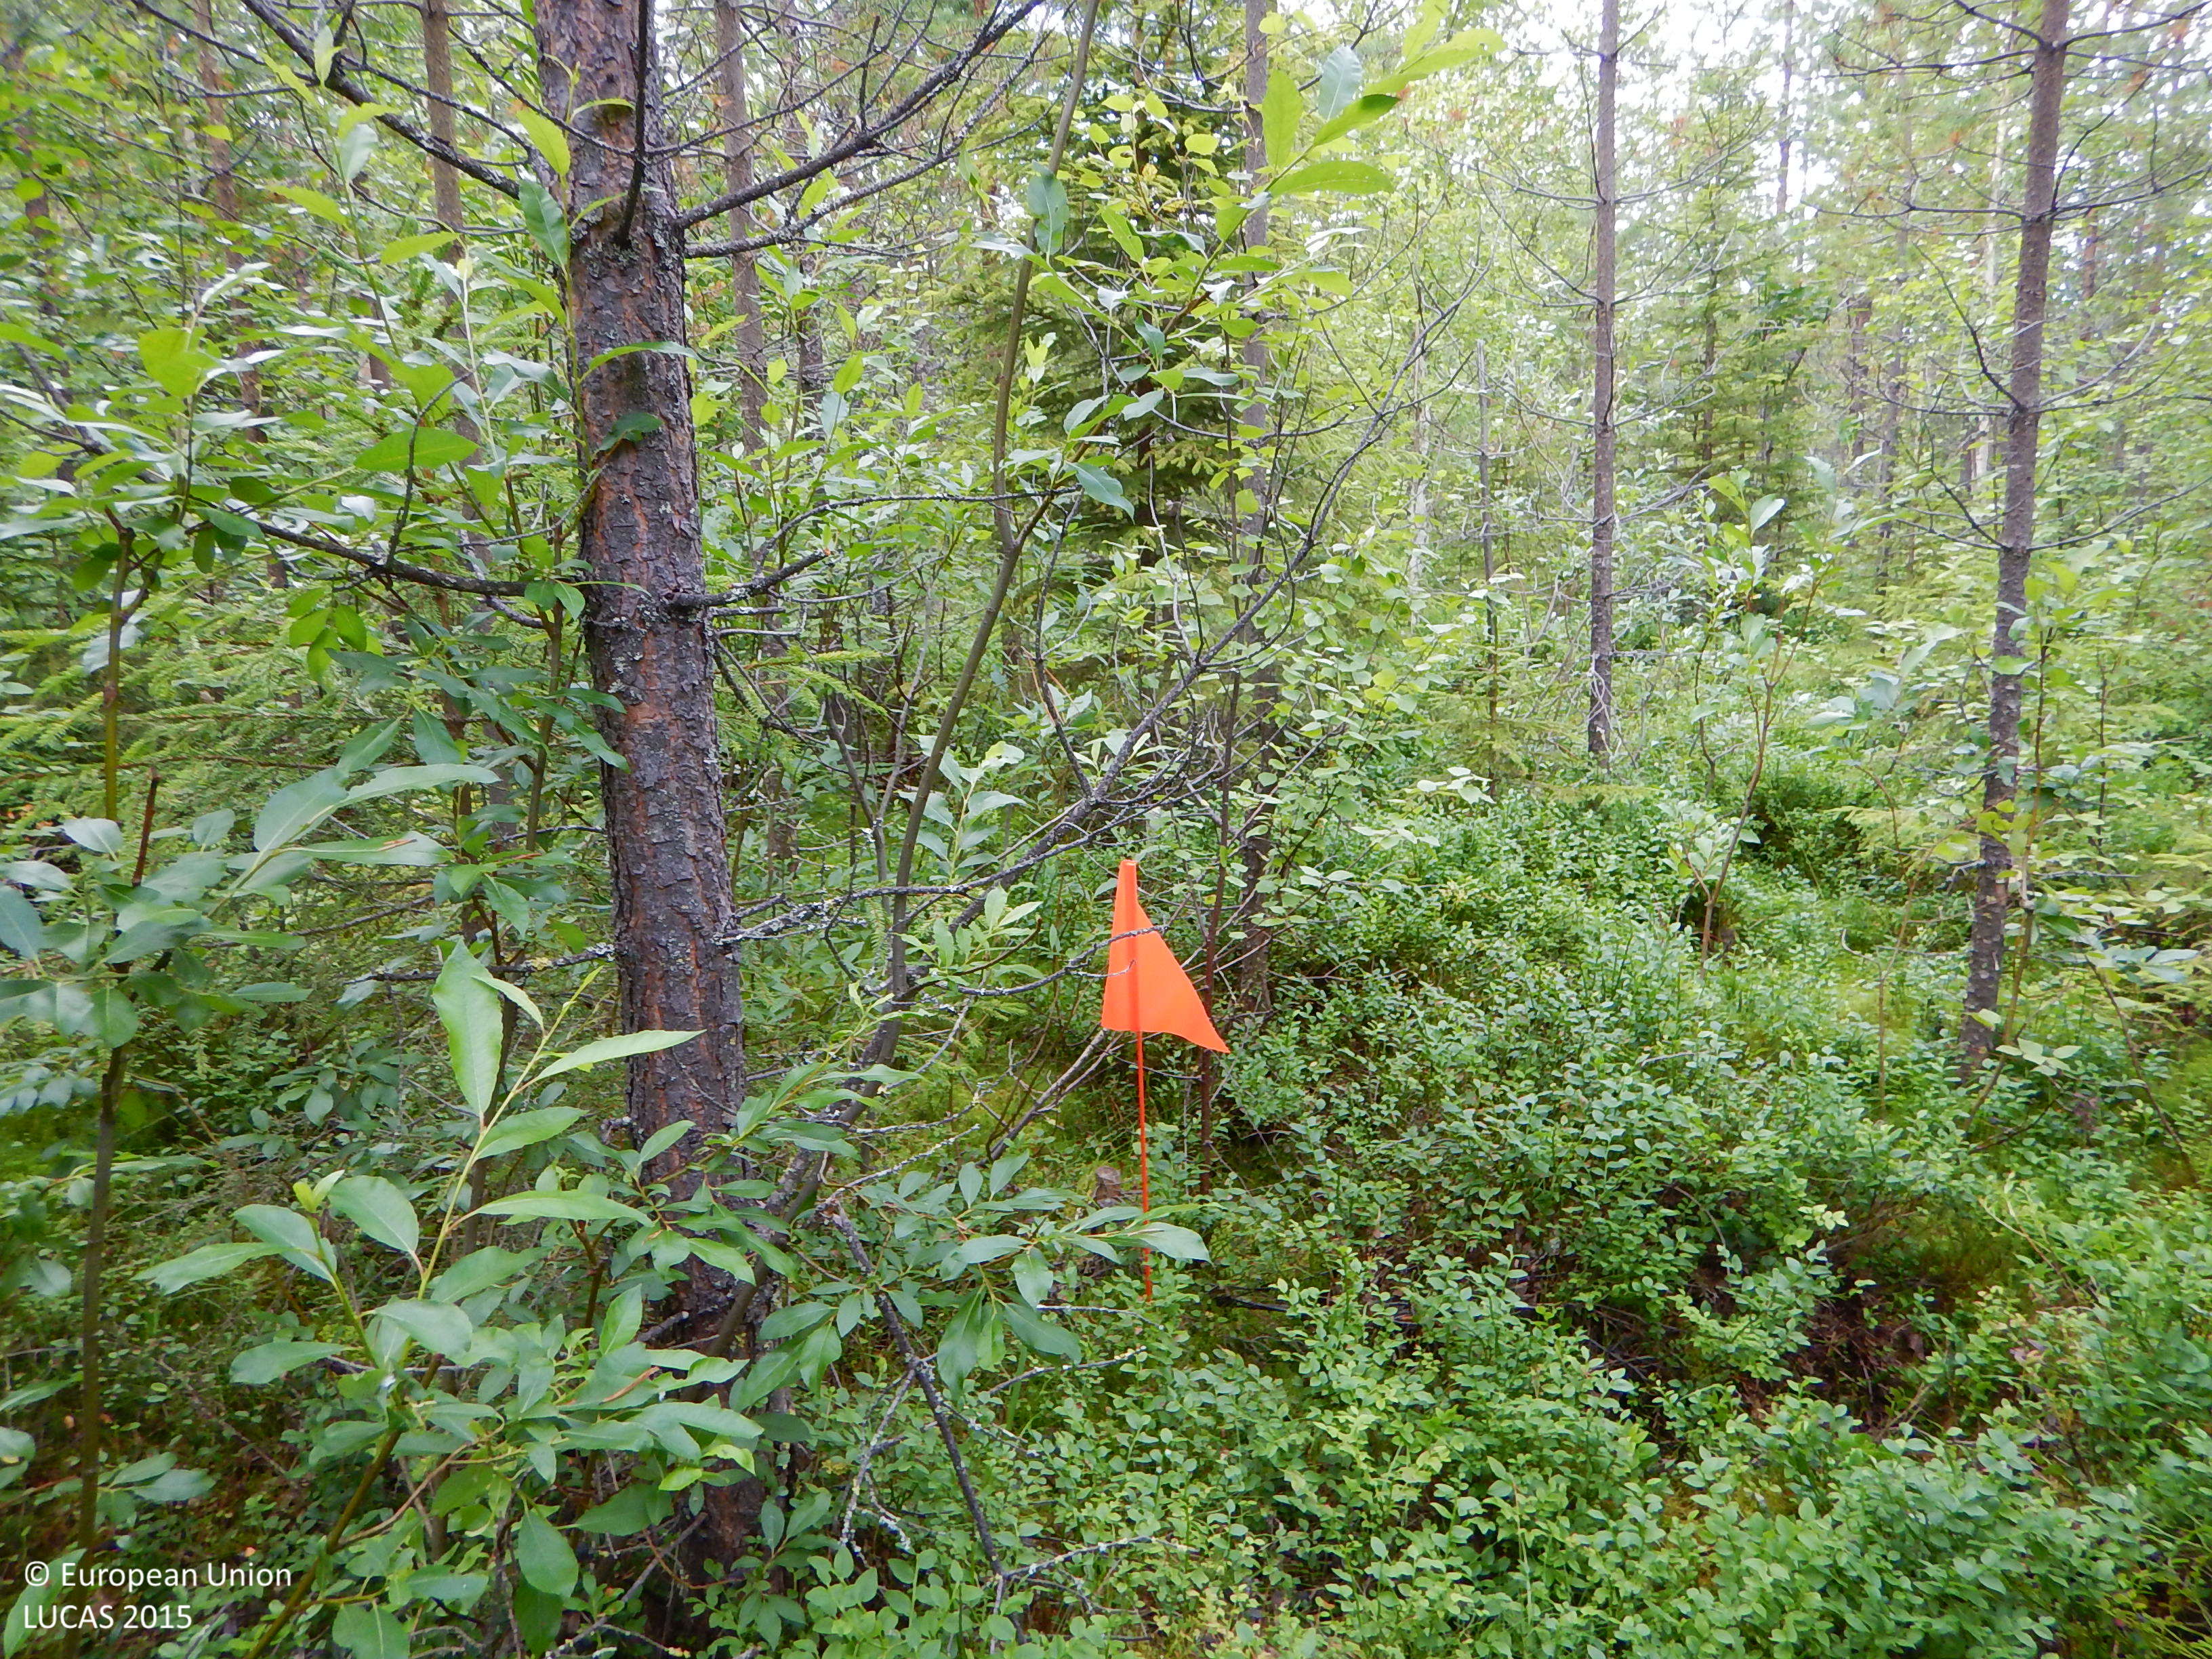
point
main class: Woodland
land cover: Pine dominated mixed woodland
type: boreal forest
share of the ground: 50 - 75 %
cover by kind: coniferous forest trees 50 %, broadleaved forest trees 20 %, shrubs 10 %, herbaceous plants 10 %, lichens and mosses 10 %
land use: Forestry
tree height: > 5 m
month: July
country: SE
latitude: 64.8302
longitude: 20.2772
